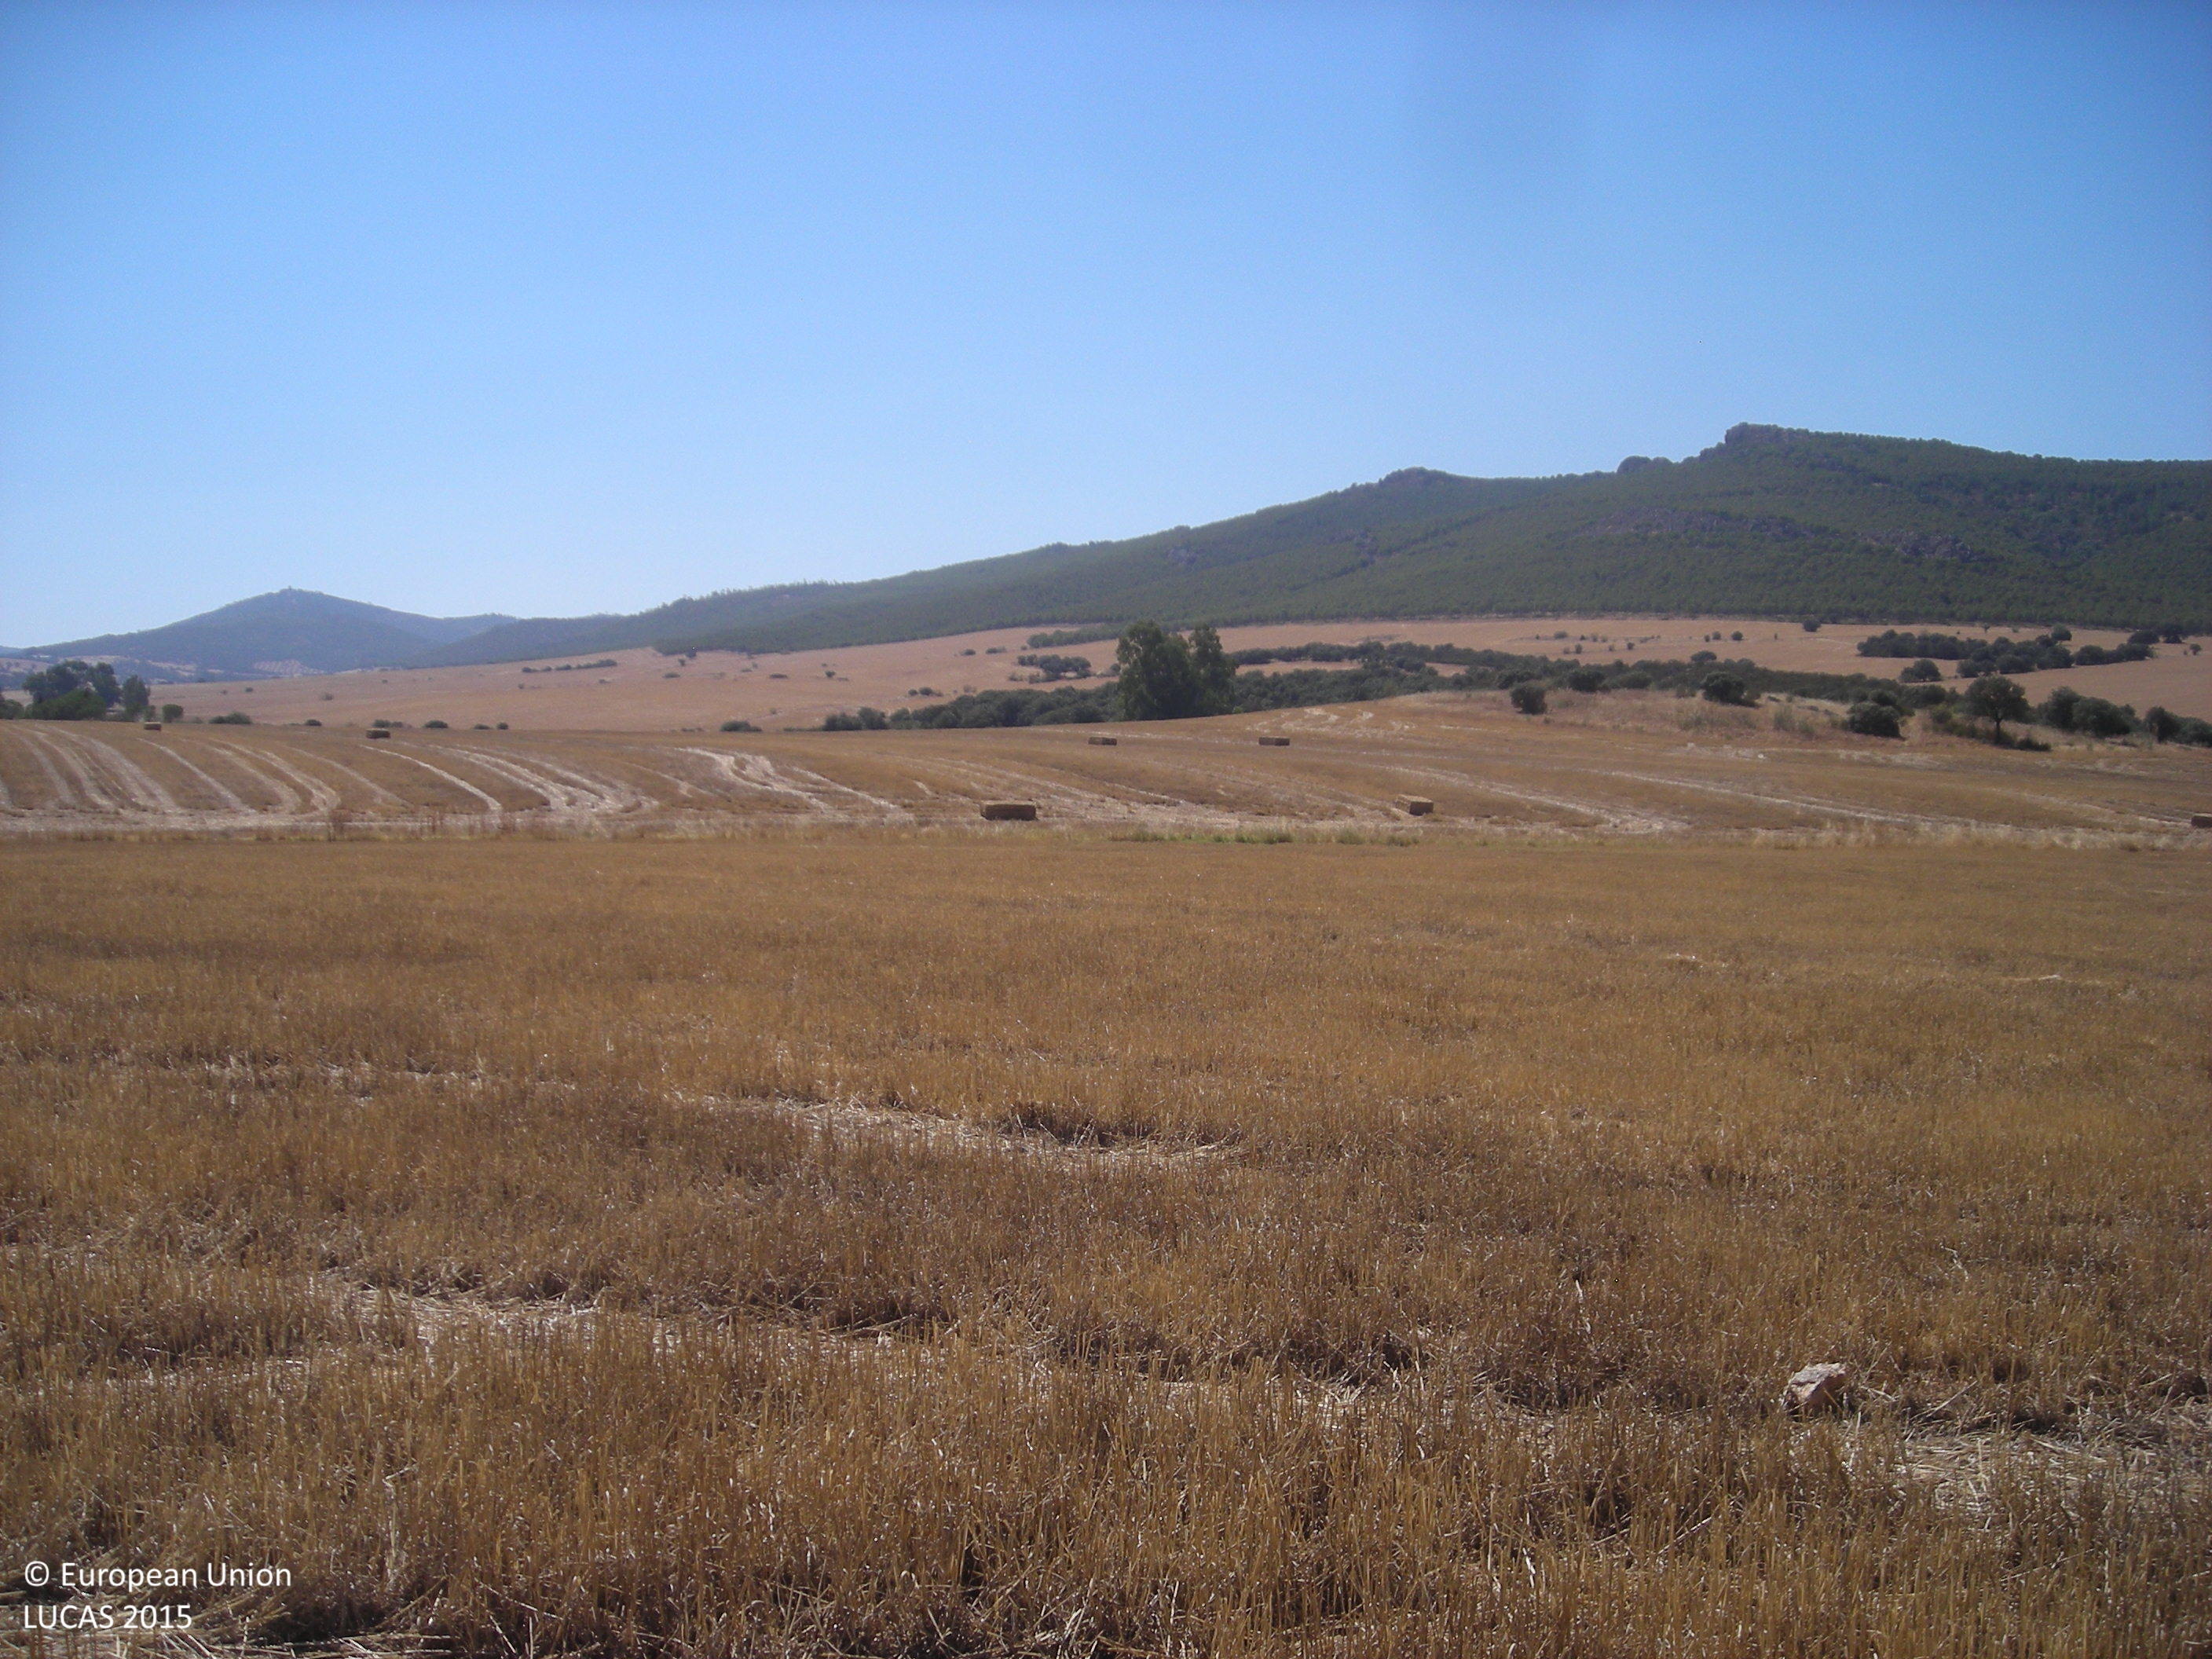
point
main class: Cropland
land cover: Mixed cereals for fodder
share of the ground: > 75 %
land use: Agriculture (excluding fallow land and kitchen gardens)
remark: Harvested field
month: July
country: ES
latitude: 38.8169
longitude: -5.8833
